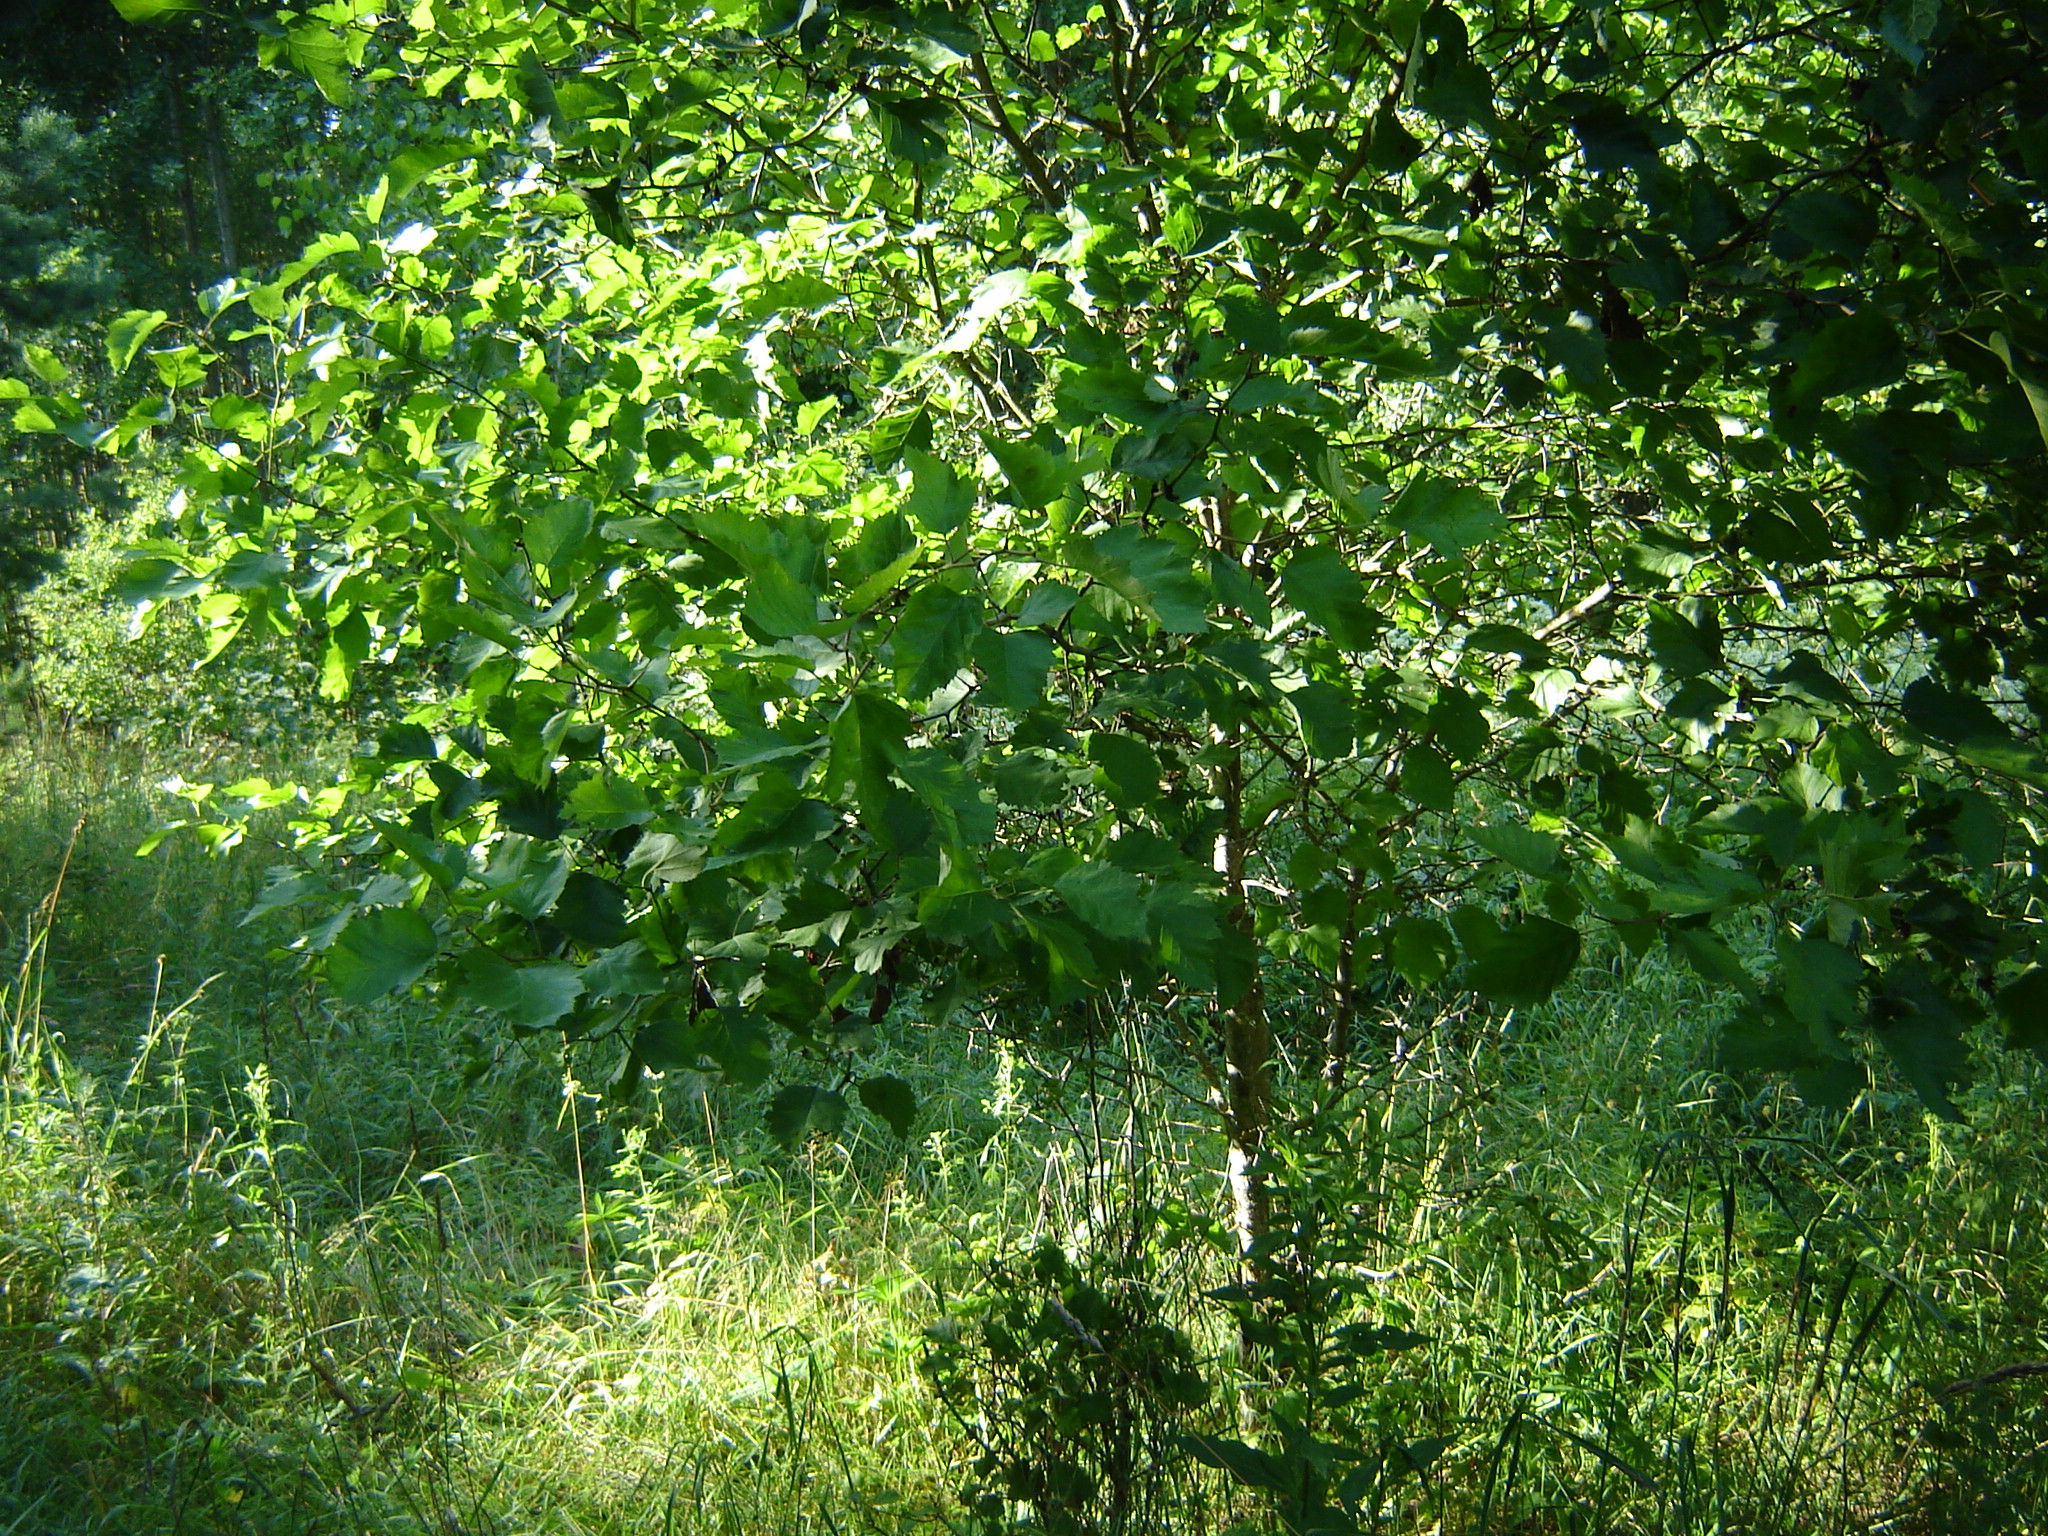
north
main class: Woodland
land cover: Pine dominated mixed woodland
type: hemiboreal forest and nemoral coniferous forest and mixed broadleaved-coniferous forest
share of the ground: > 75 %
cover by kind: coniferous forest trees 45 %, broadleaved forest trees 30 %, herbaceous plants 25 %
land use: Forestry
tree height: > 5 m
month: July
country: LT
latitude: 55.2988
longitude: 25.4489
